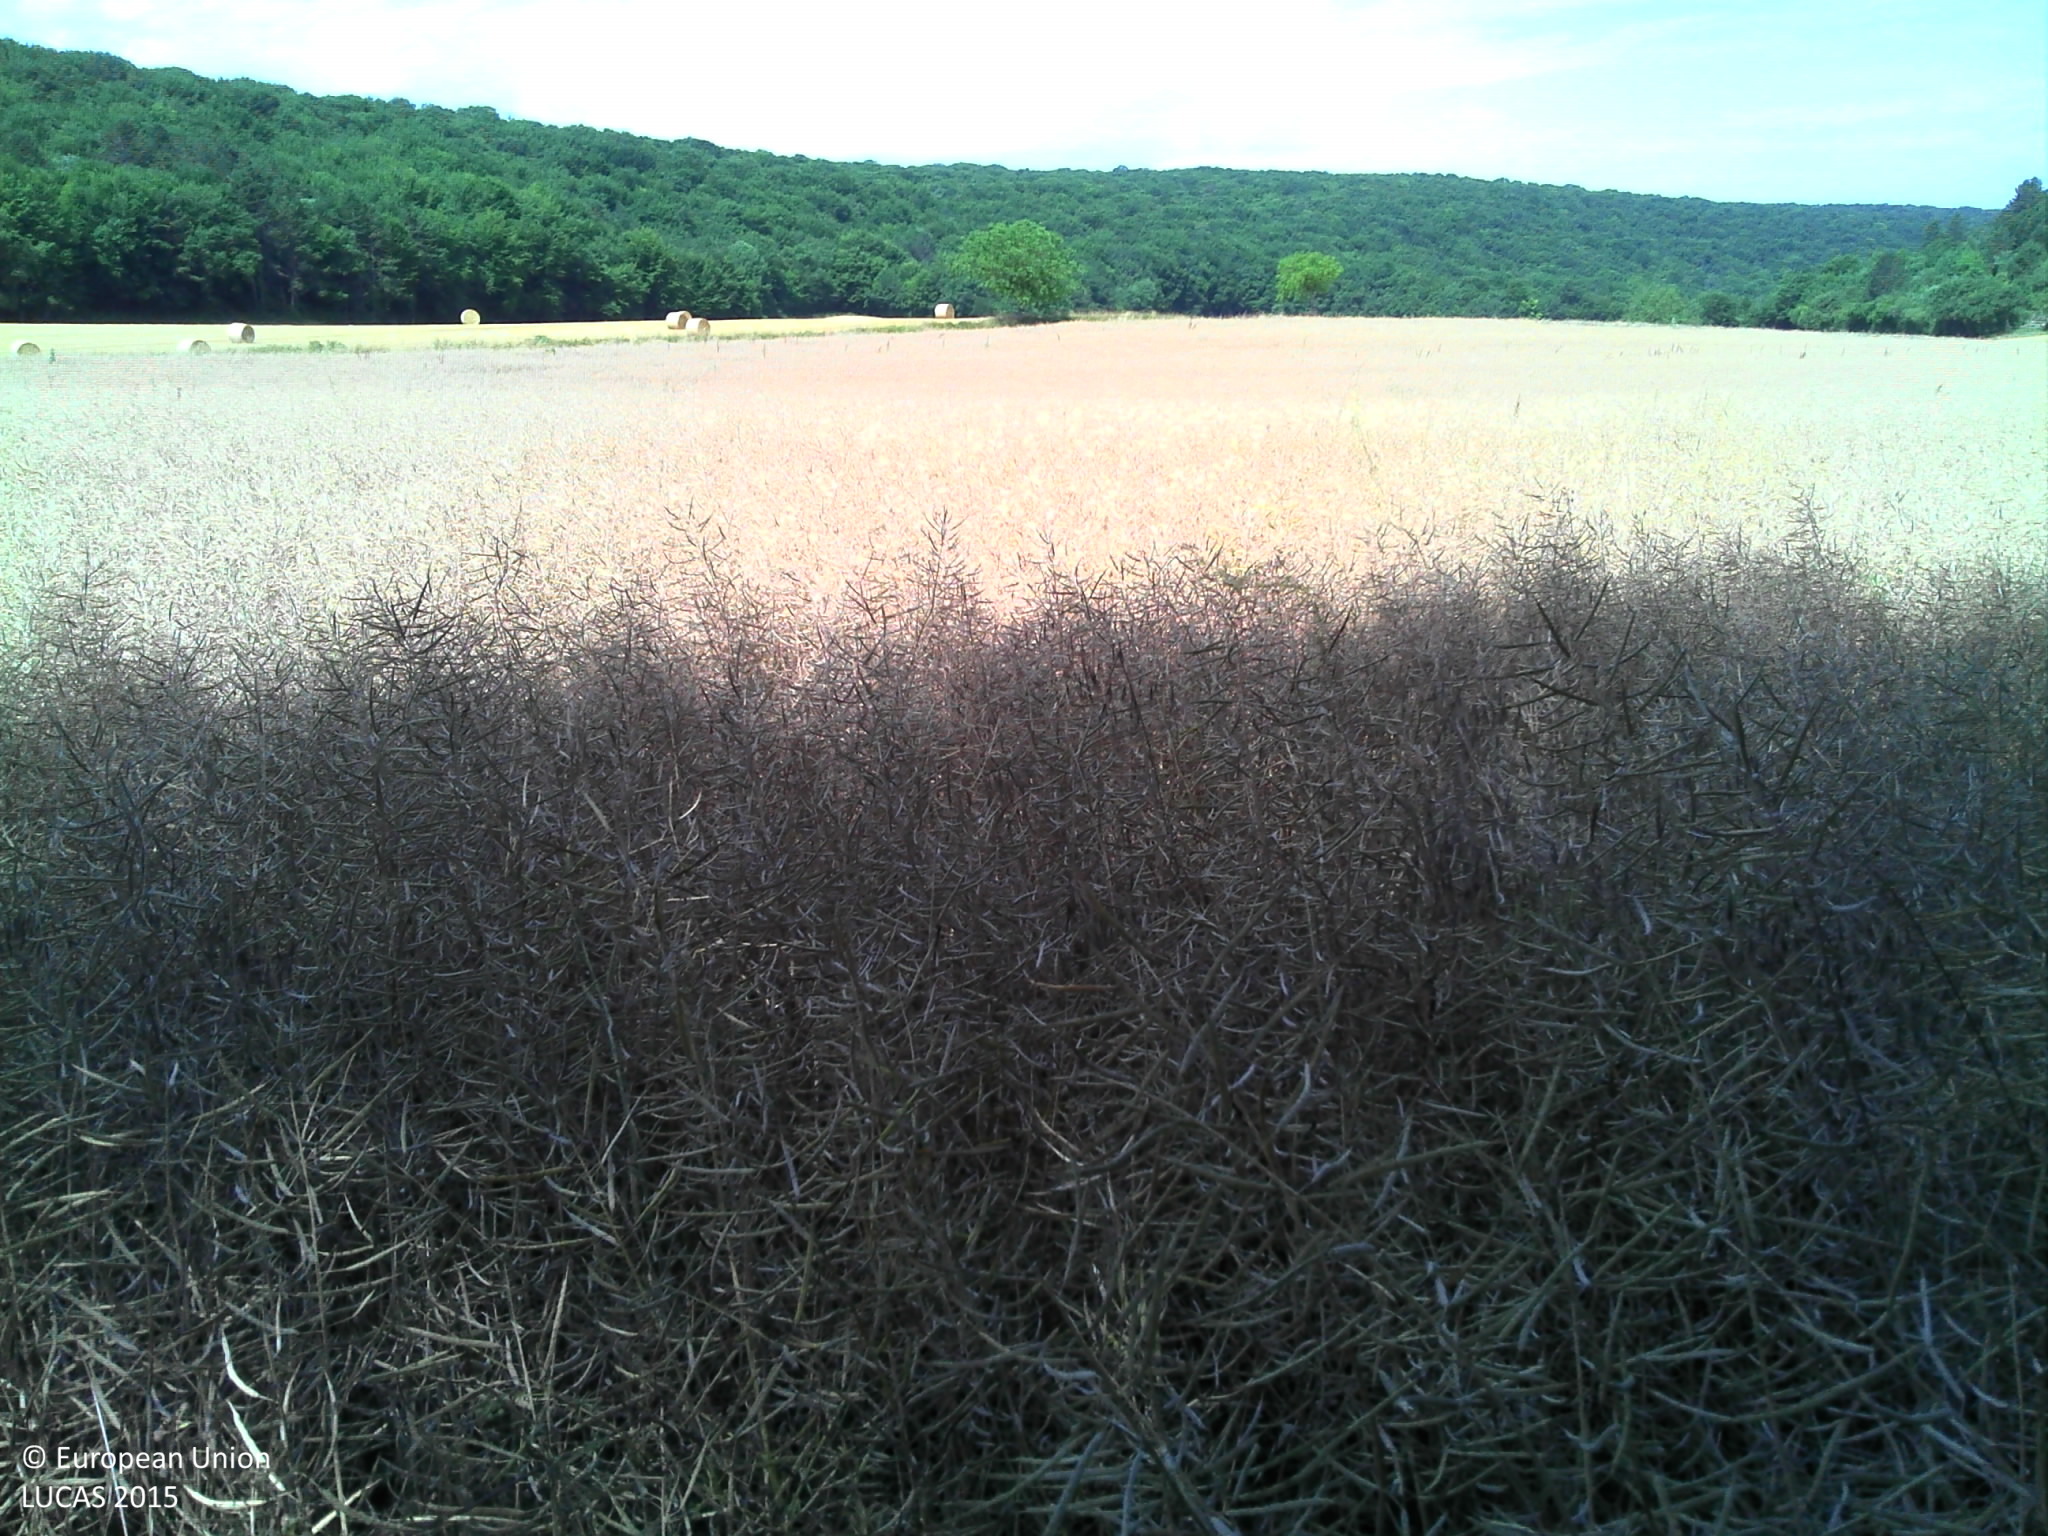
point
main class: Cropland
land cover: Rape and turnip rape
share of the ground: > 75 %
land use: Agriculture (excluding fallow land and kitchen gardens)
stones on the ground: < 10 %
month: July
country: FR
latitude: 47.3291
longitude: 3.5261
